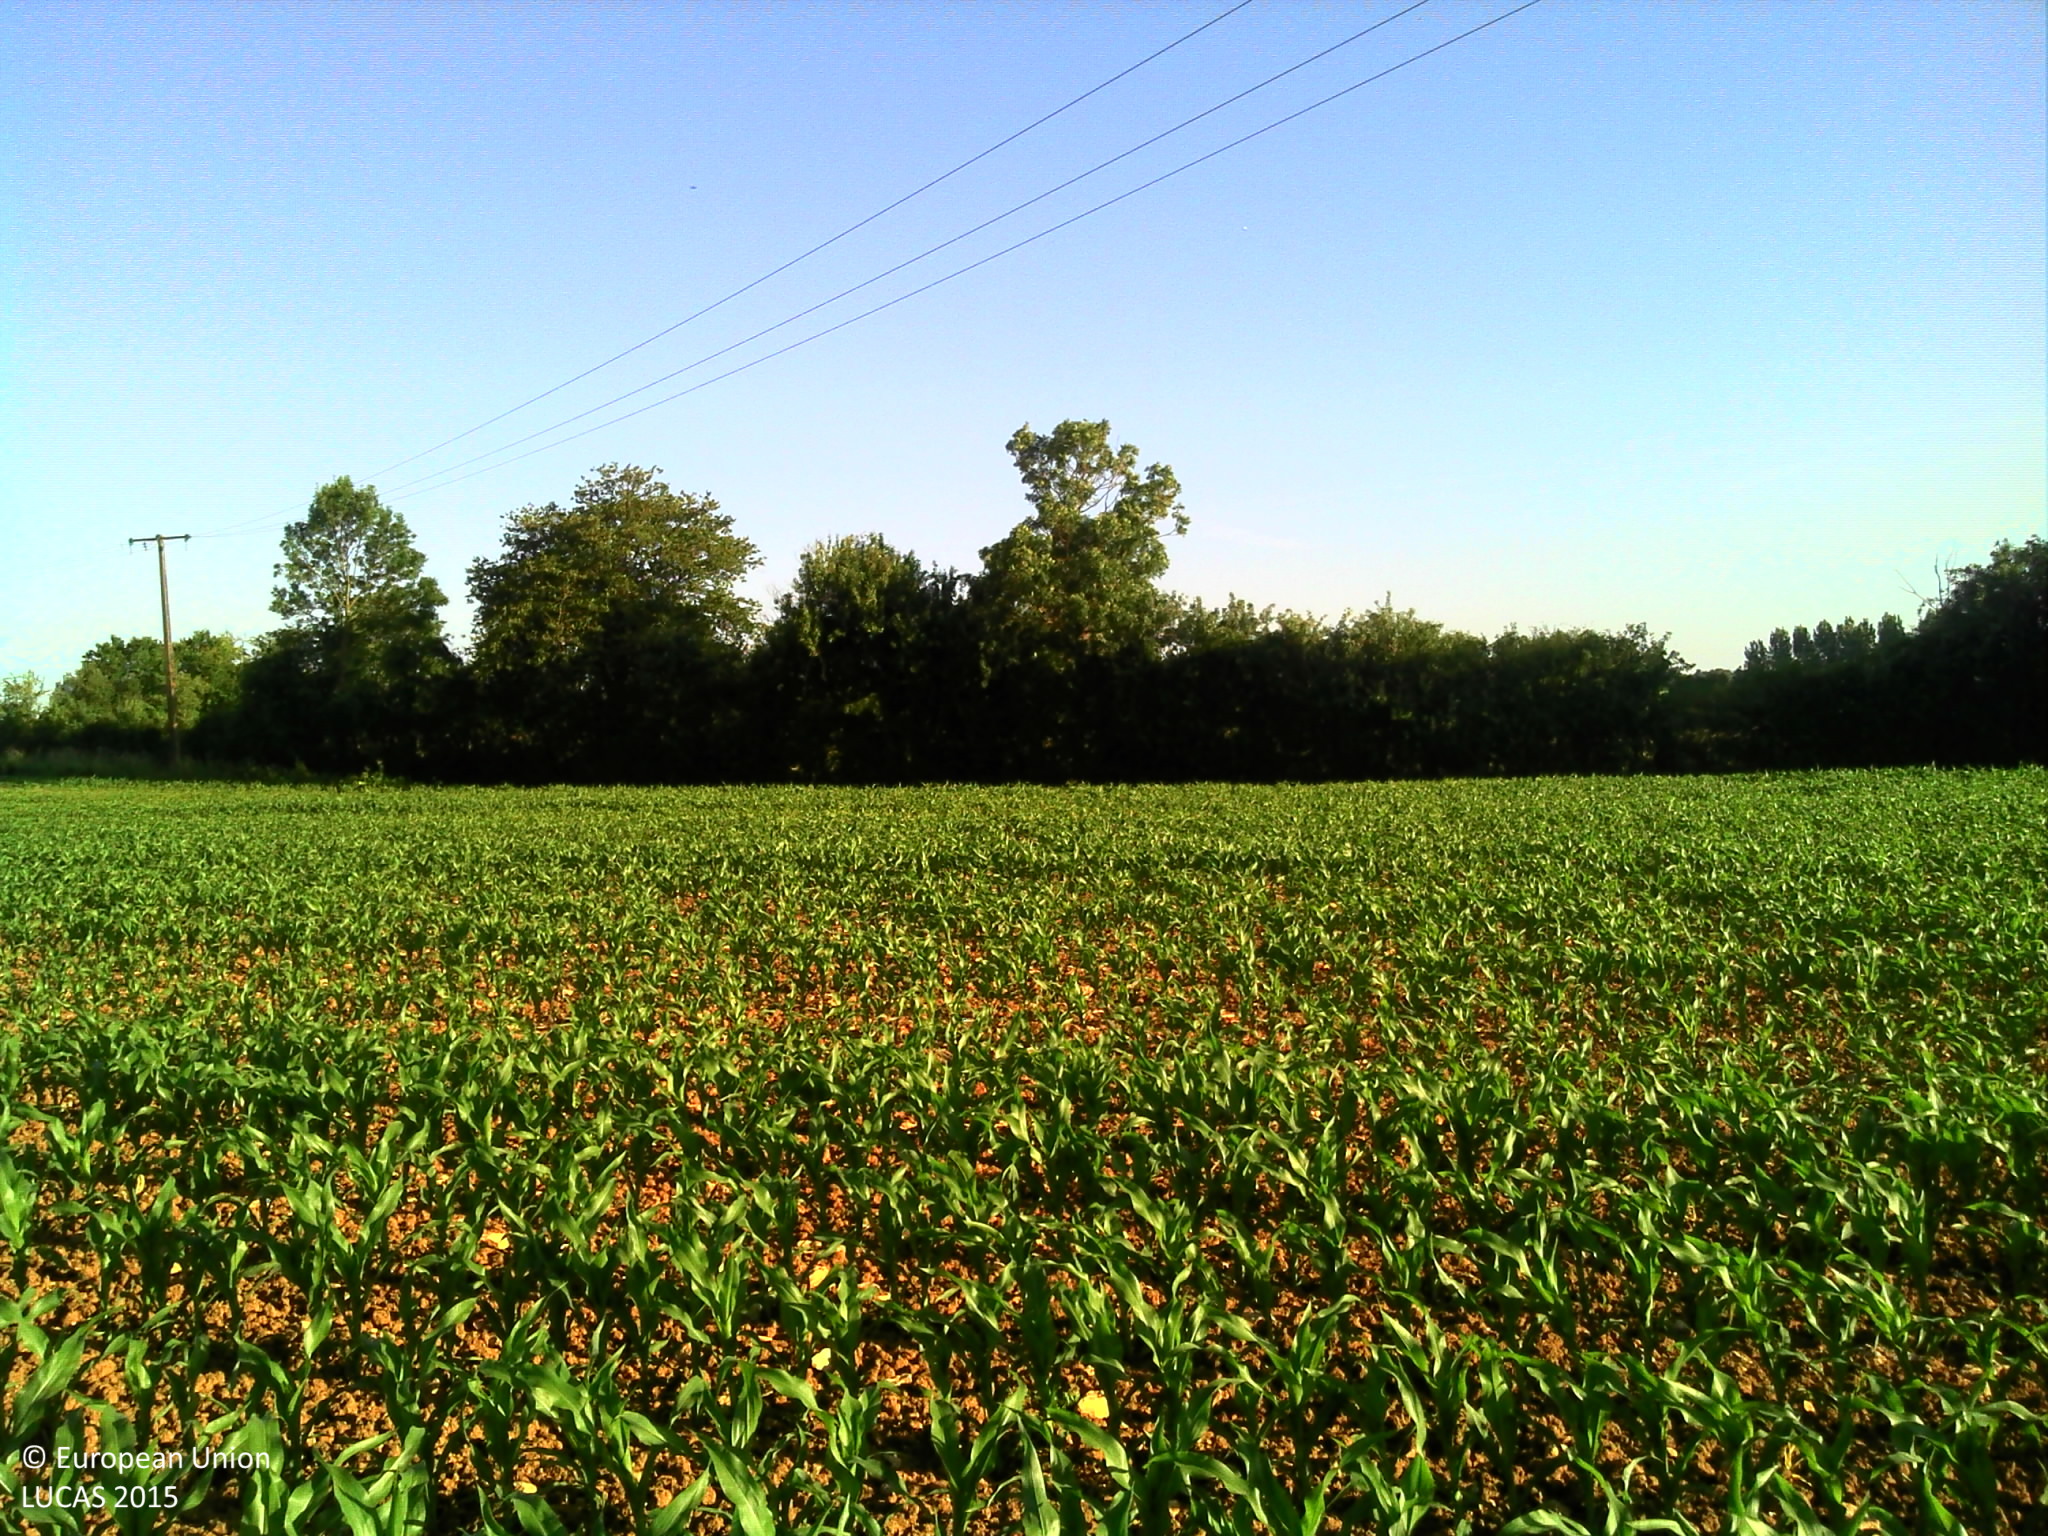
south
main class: Cropland
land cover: Maize
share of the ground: 25 - 50 %
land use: Agriculture (excluding fallow land and kitchen gardens)
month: June
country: FR
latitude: 48.4846
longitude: 0.1085
